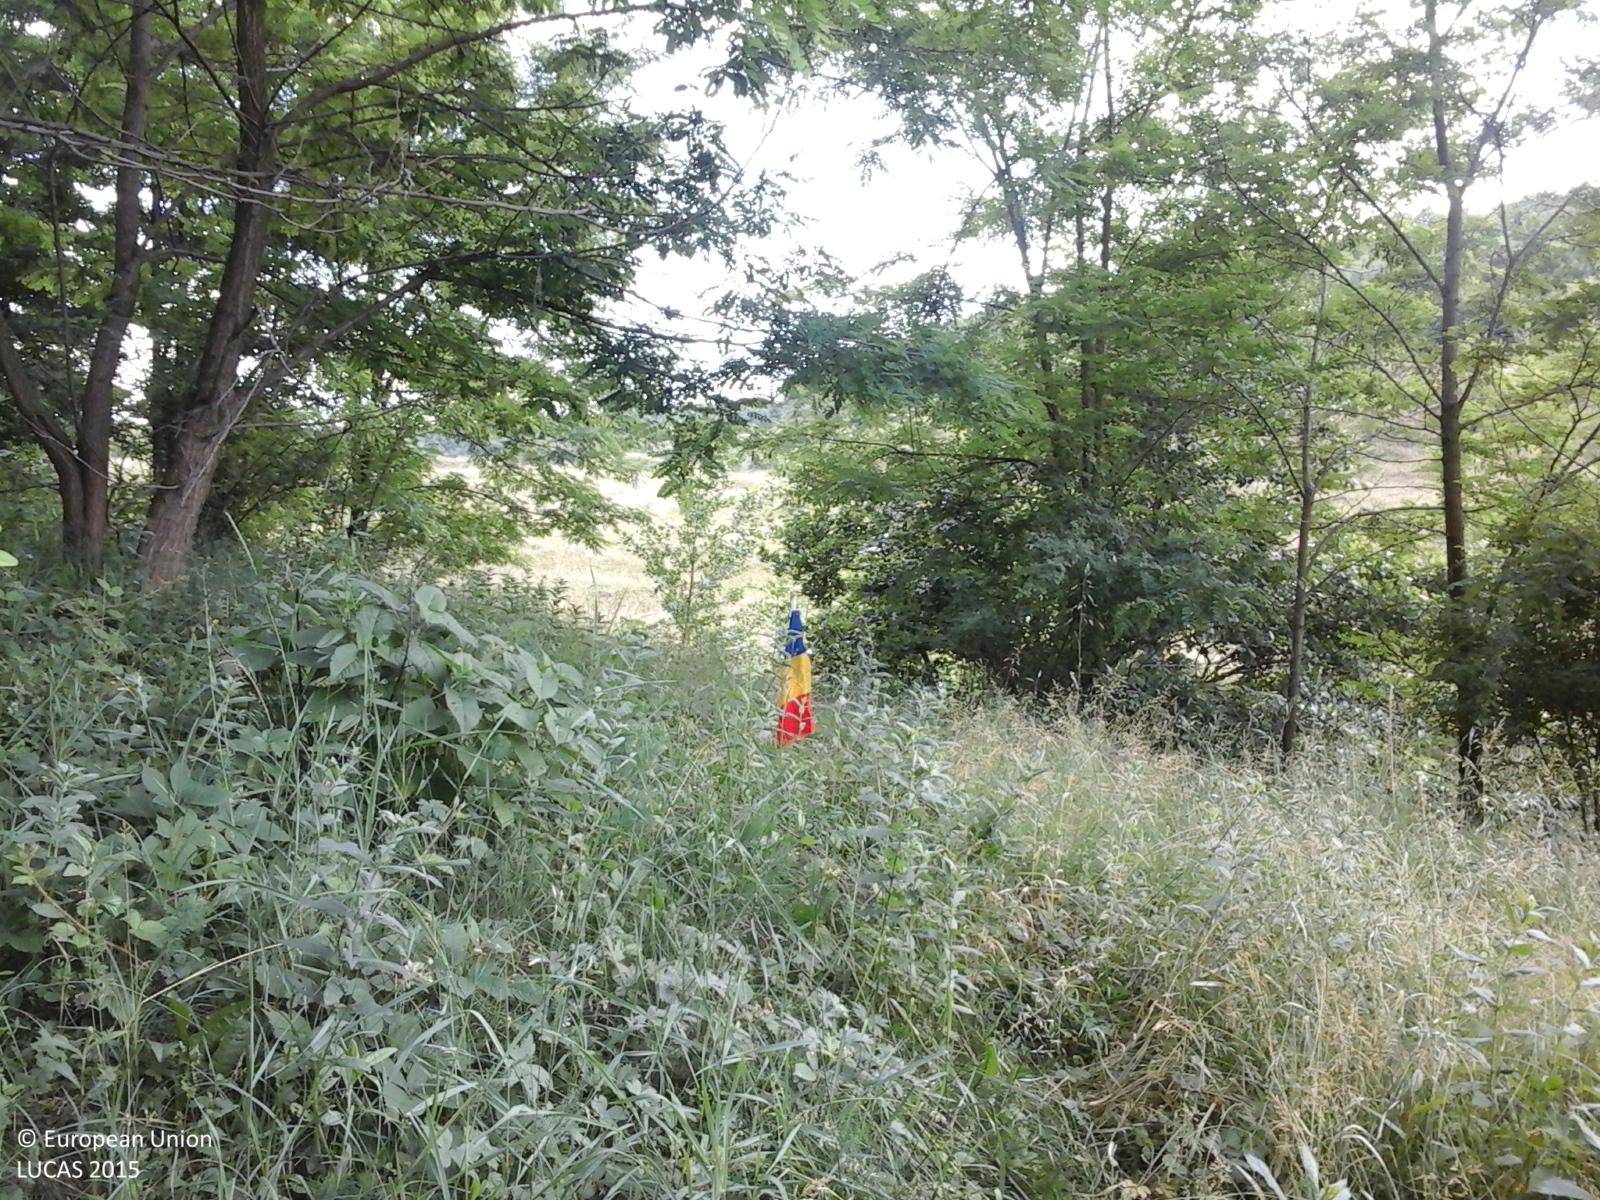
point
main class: Grassland
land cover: Grassland with sparse tree/shrub cover
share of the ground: > 75 %
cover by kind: herbaceous plants 90 %, broadleaved forest trees 5 %, shrubs 5 %
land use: Agriculture (excluding fallow land and kitchen gardens)
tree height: > 5 m
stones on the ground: < 10 %
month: June
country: RO
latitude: 47.4417
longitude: 26.4098
